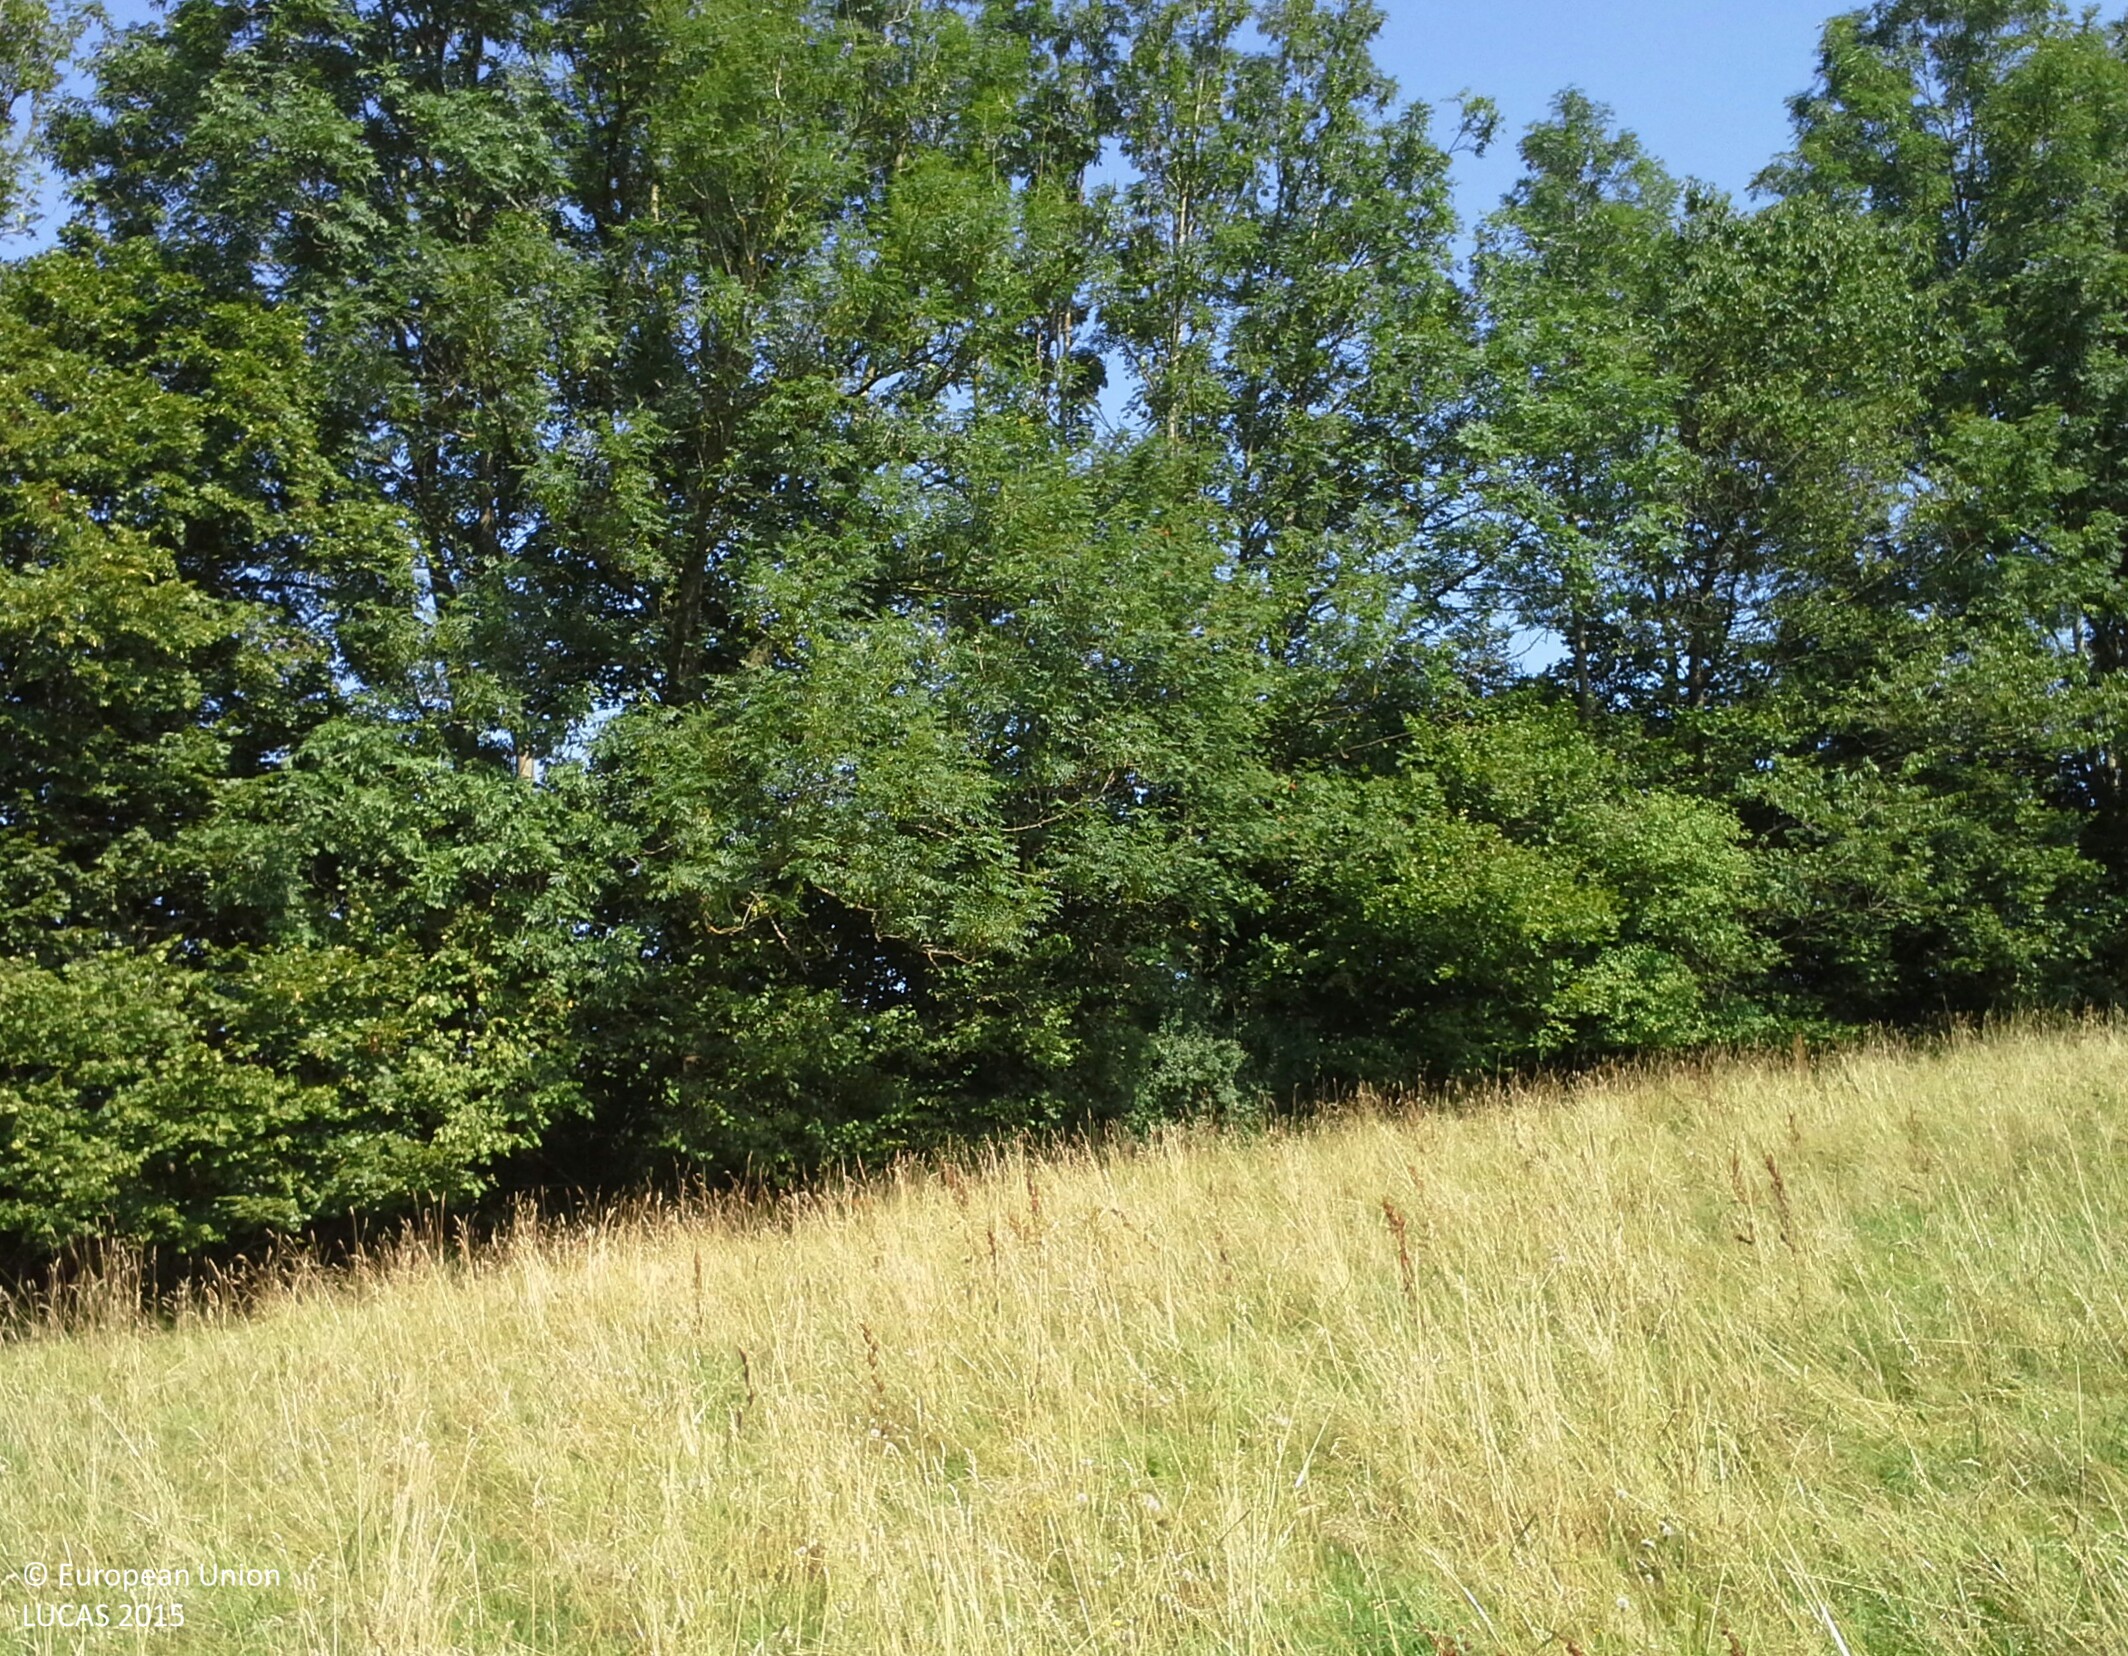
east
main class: Grassland
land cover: Grassland without tree/shrub cover
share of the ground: > 75 %
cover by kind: herbaceous plants 100 %
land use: Agriculture (excluding fallow land and kitchen gardens)
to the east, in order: Grassland without tree/shrub cover; Broadleaved woodland; Fences; Grassland without tree/shrub cover; Electric lines; Grassland without tree/shrub cover; Paved roads, cycling and walking lanes; Grassland without tree/shrub cover
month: July
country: AT
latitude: 47.9553
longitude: 14.8346
